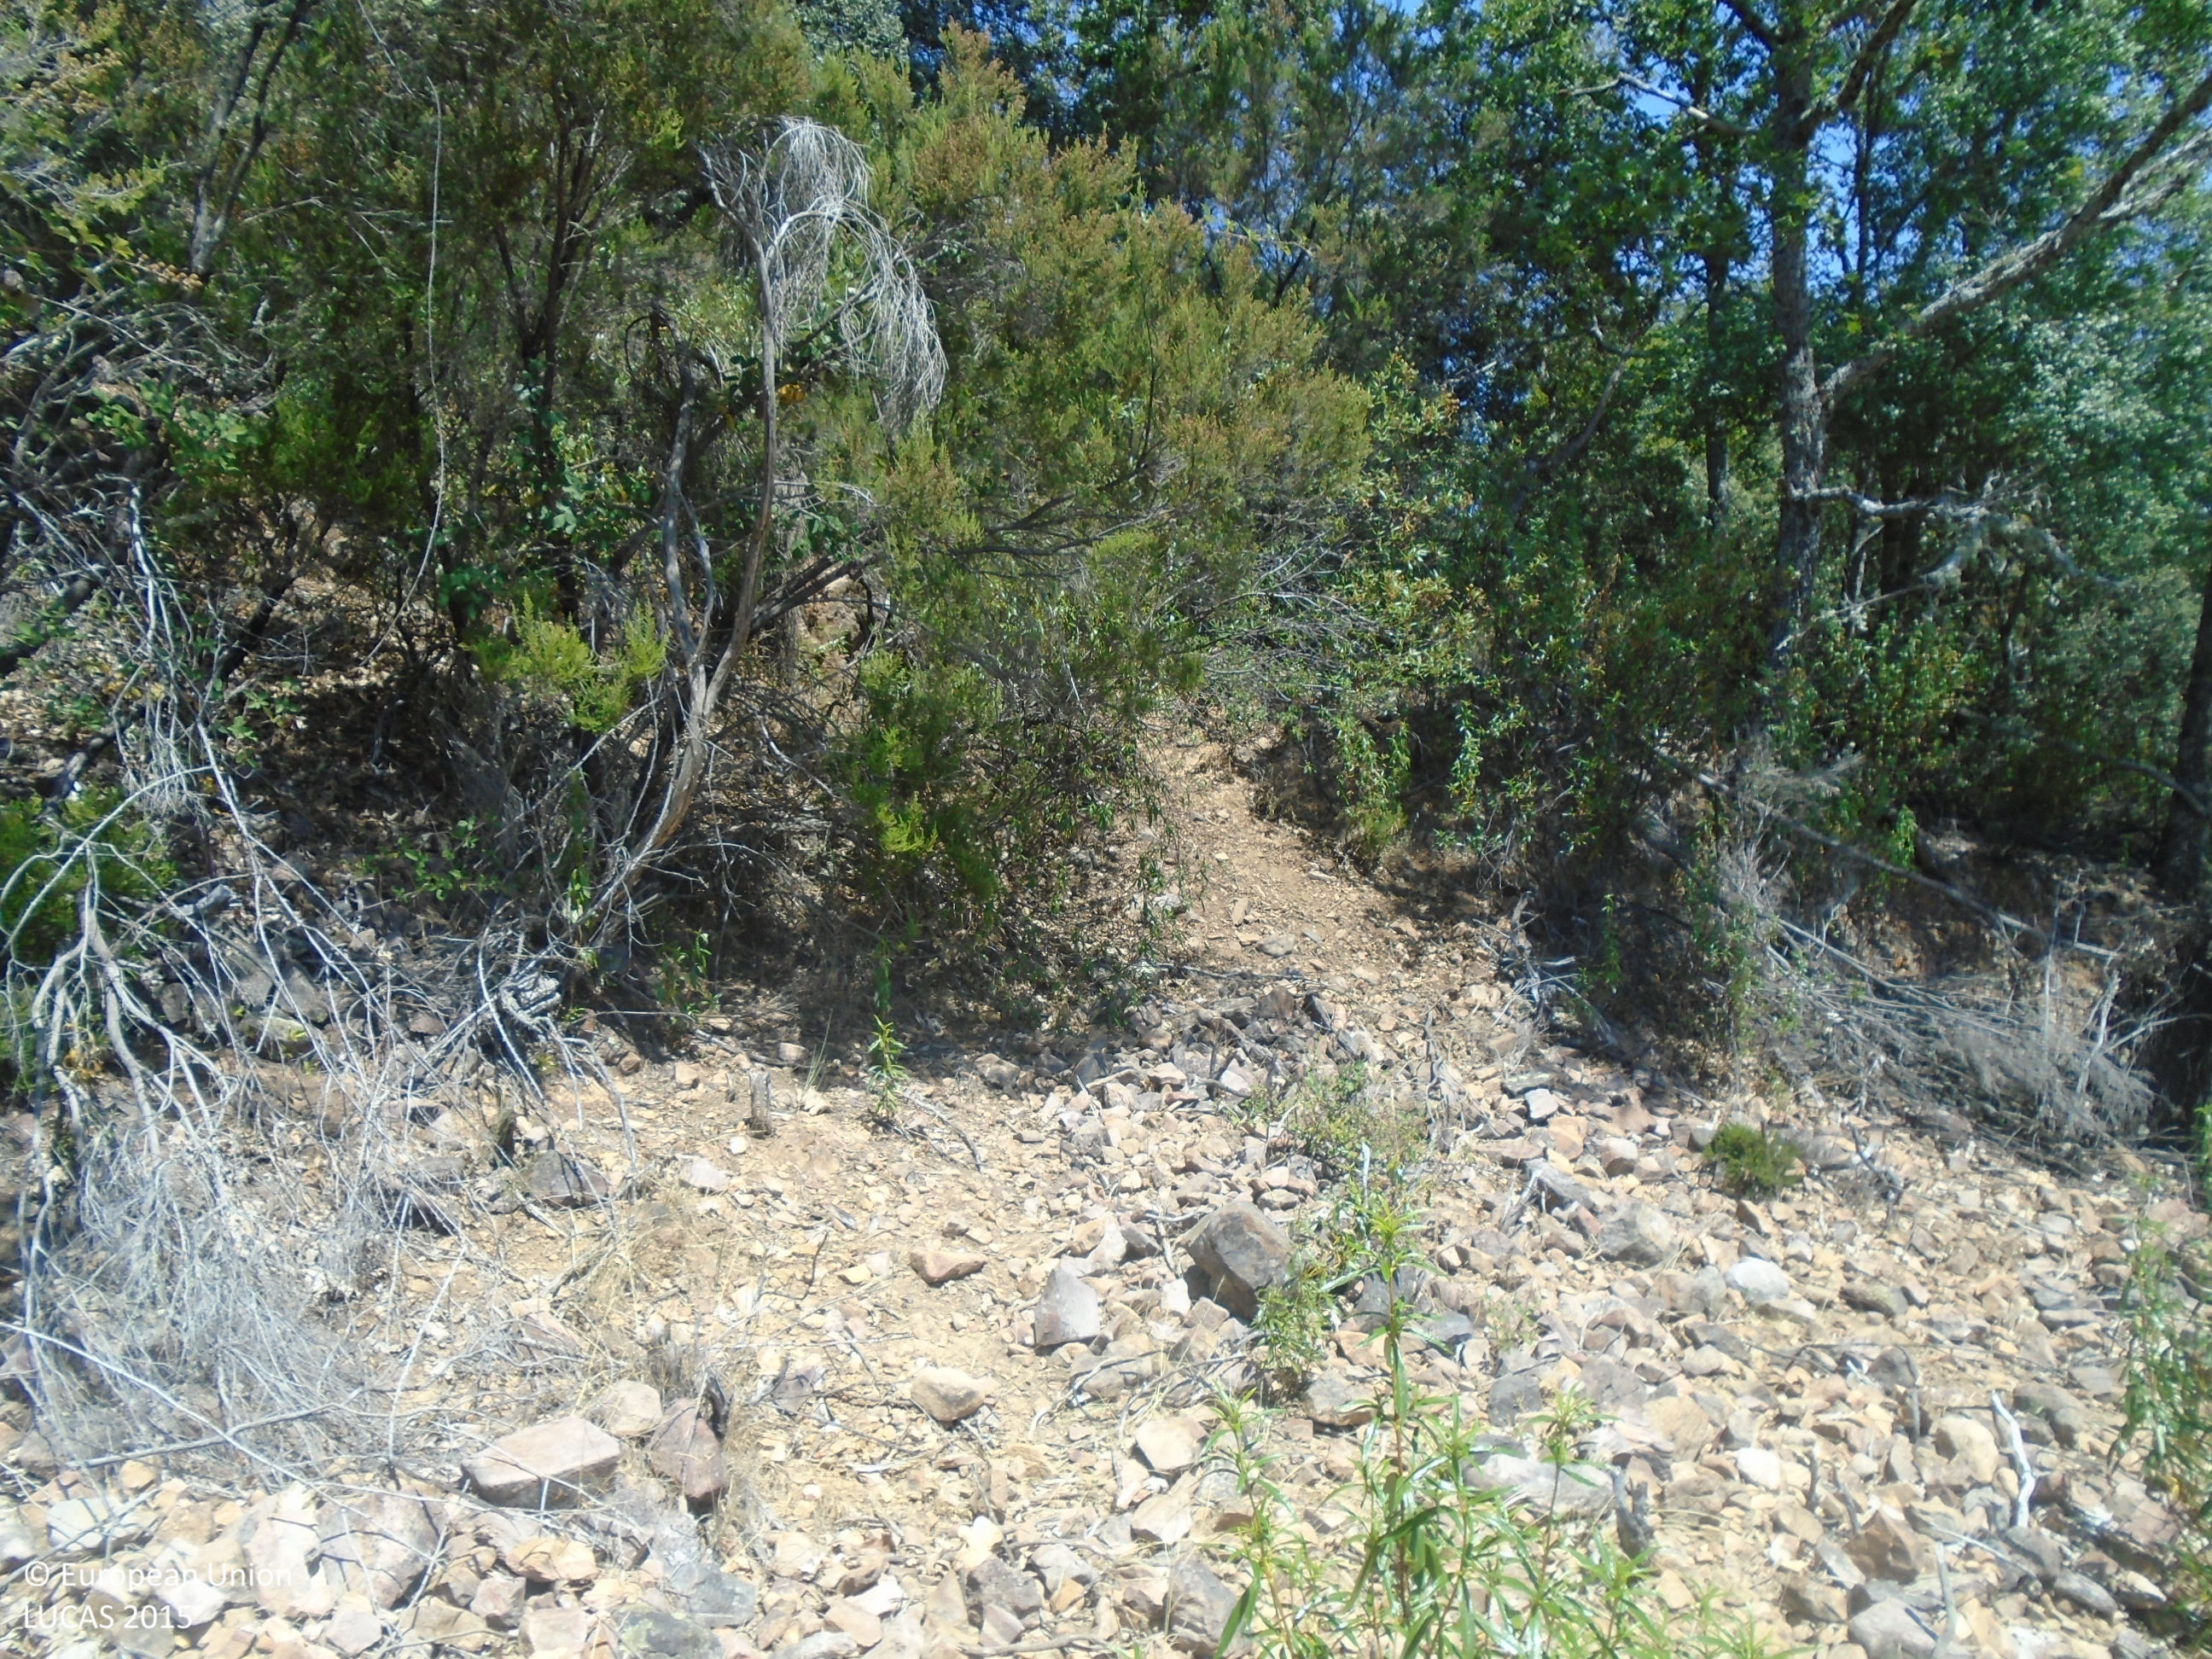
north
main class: Woodland
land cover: Broadleaved woodland
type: broadleaved evergreen forest
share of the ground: 25 - 50 %
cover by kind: broadleaved forest trees 45 %, unconsolidated bare surface 40 %, herbaceous plants 10 %, shrubs 5 %
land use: Semi-natural and natural areas not in use
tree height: > 5 m
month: July
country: ES
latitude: 39.5012
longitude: -4.5852
